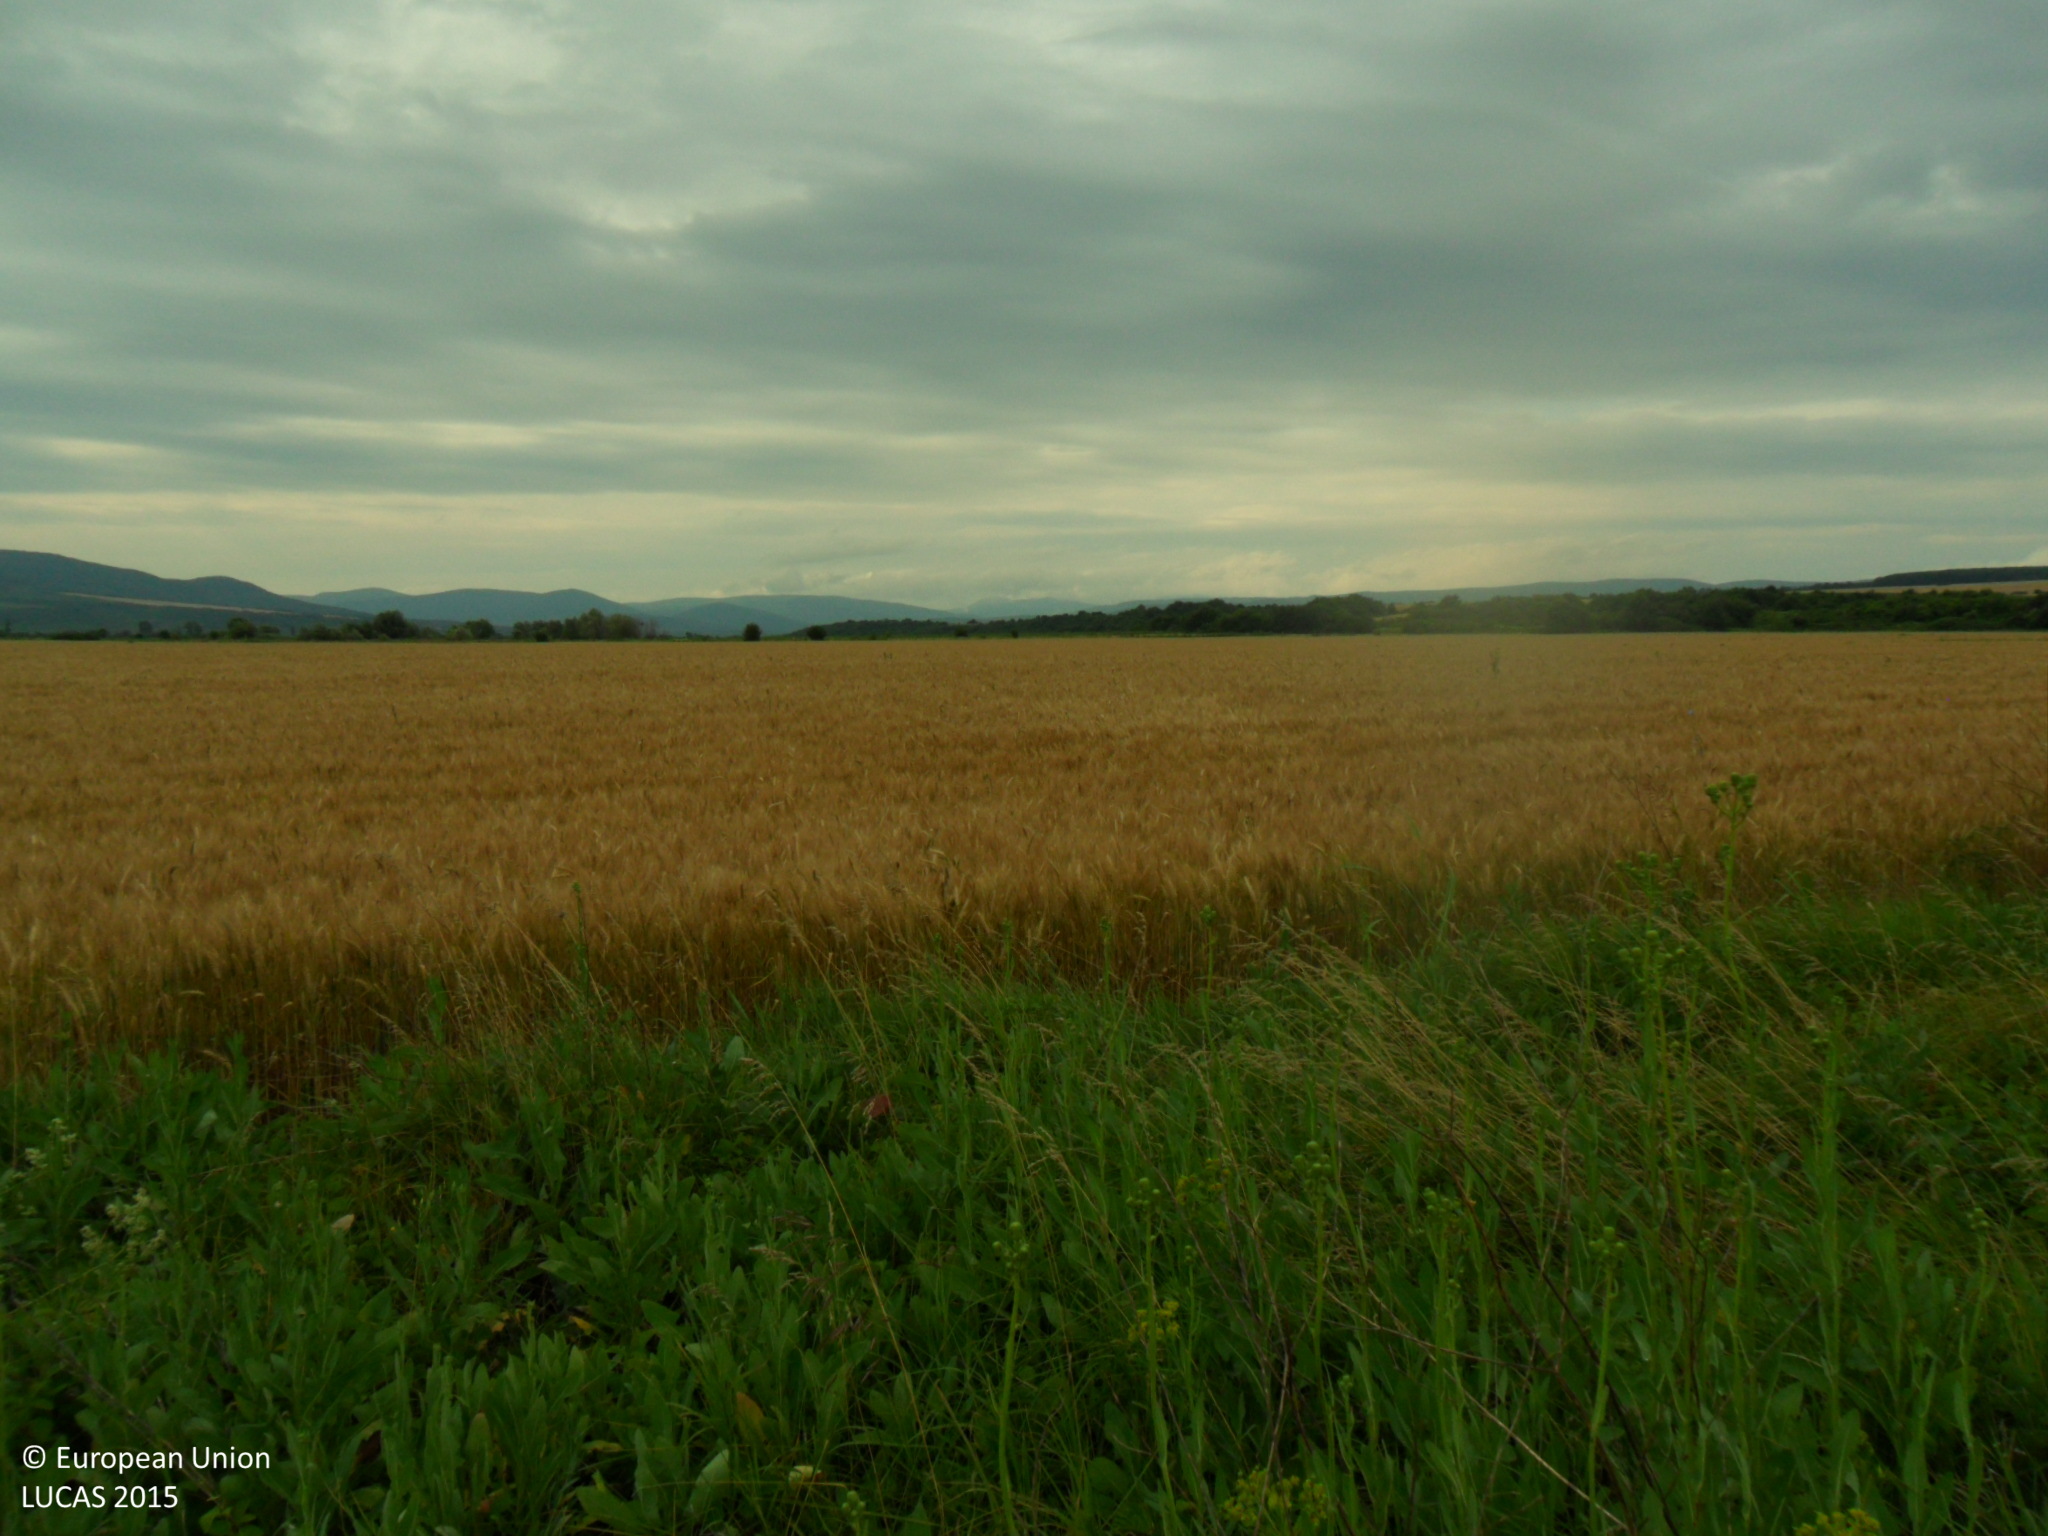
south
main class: Cropland
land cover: Common wheat
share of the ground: > 75 %
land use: Agriculture (excluding fallow land and kitchen gardens)
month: June
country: BG
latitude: 43.1564
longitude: 26.9982
